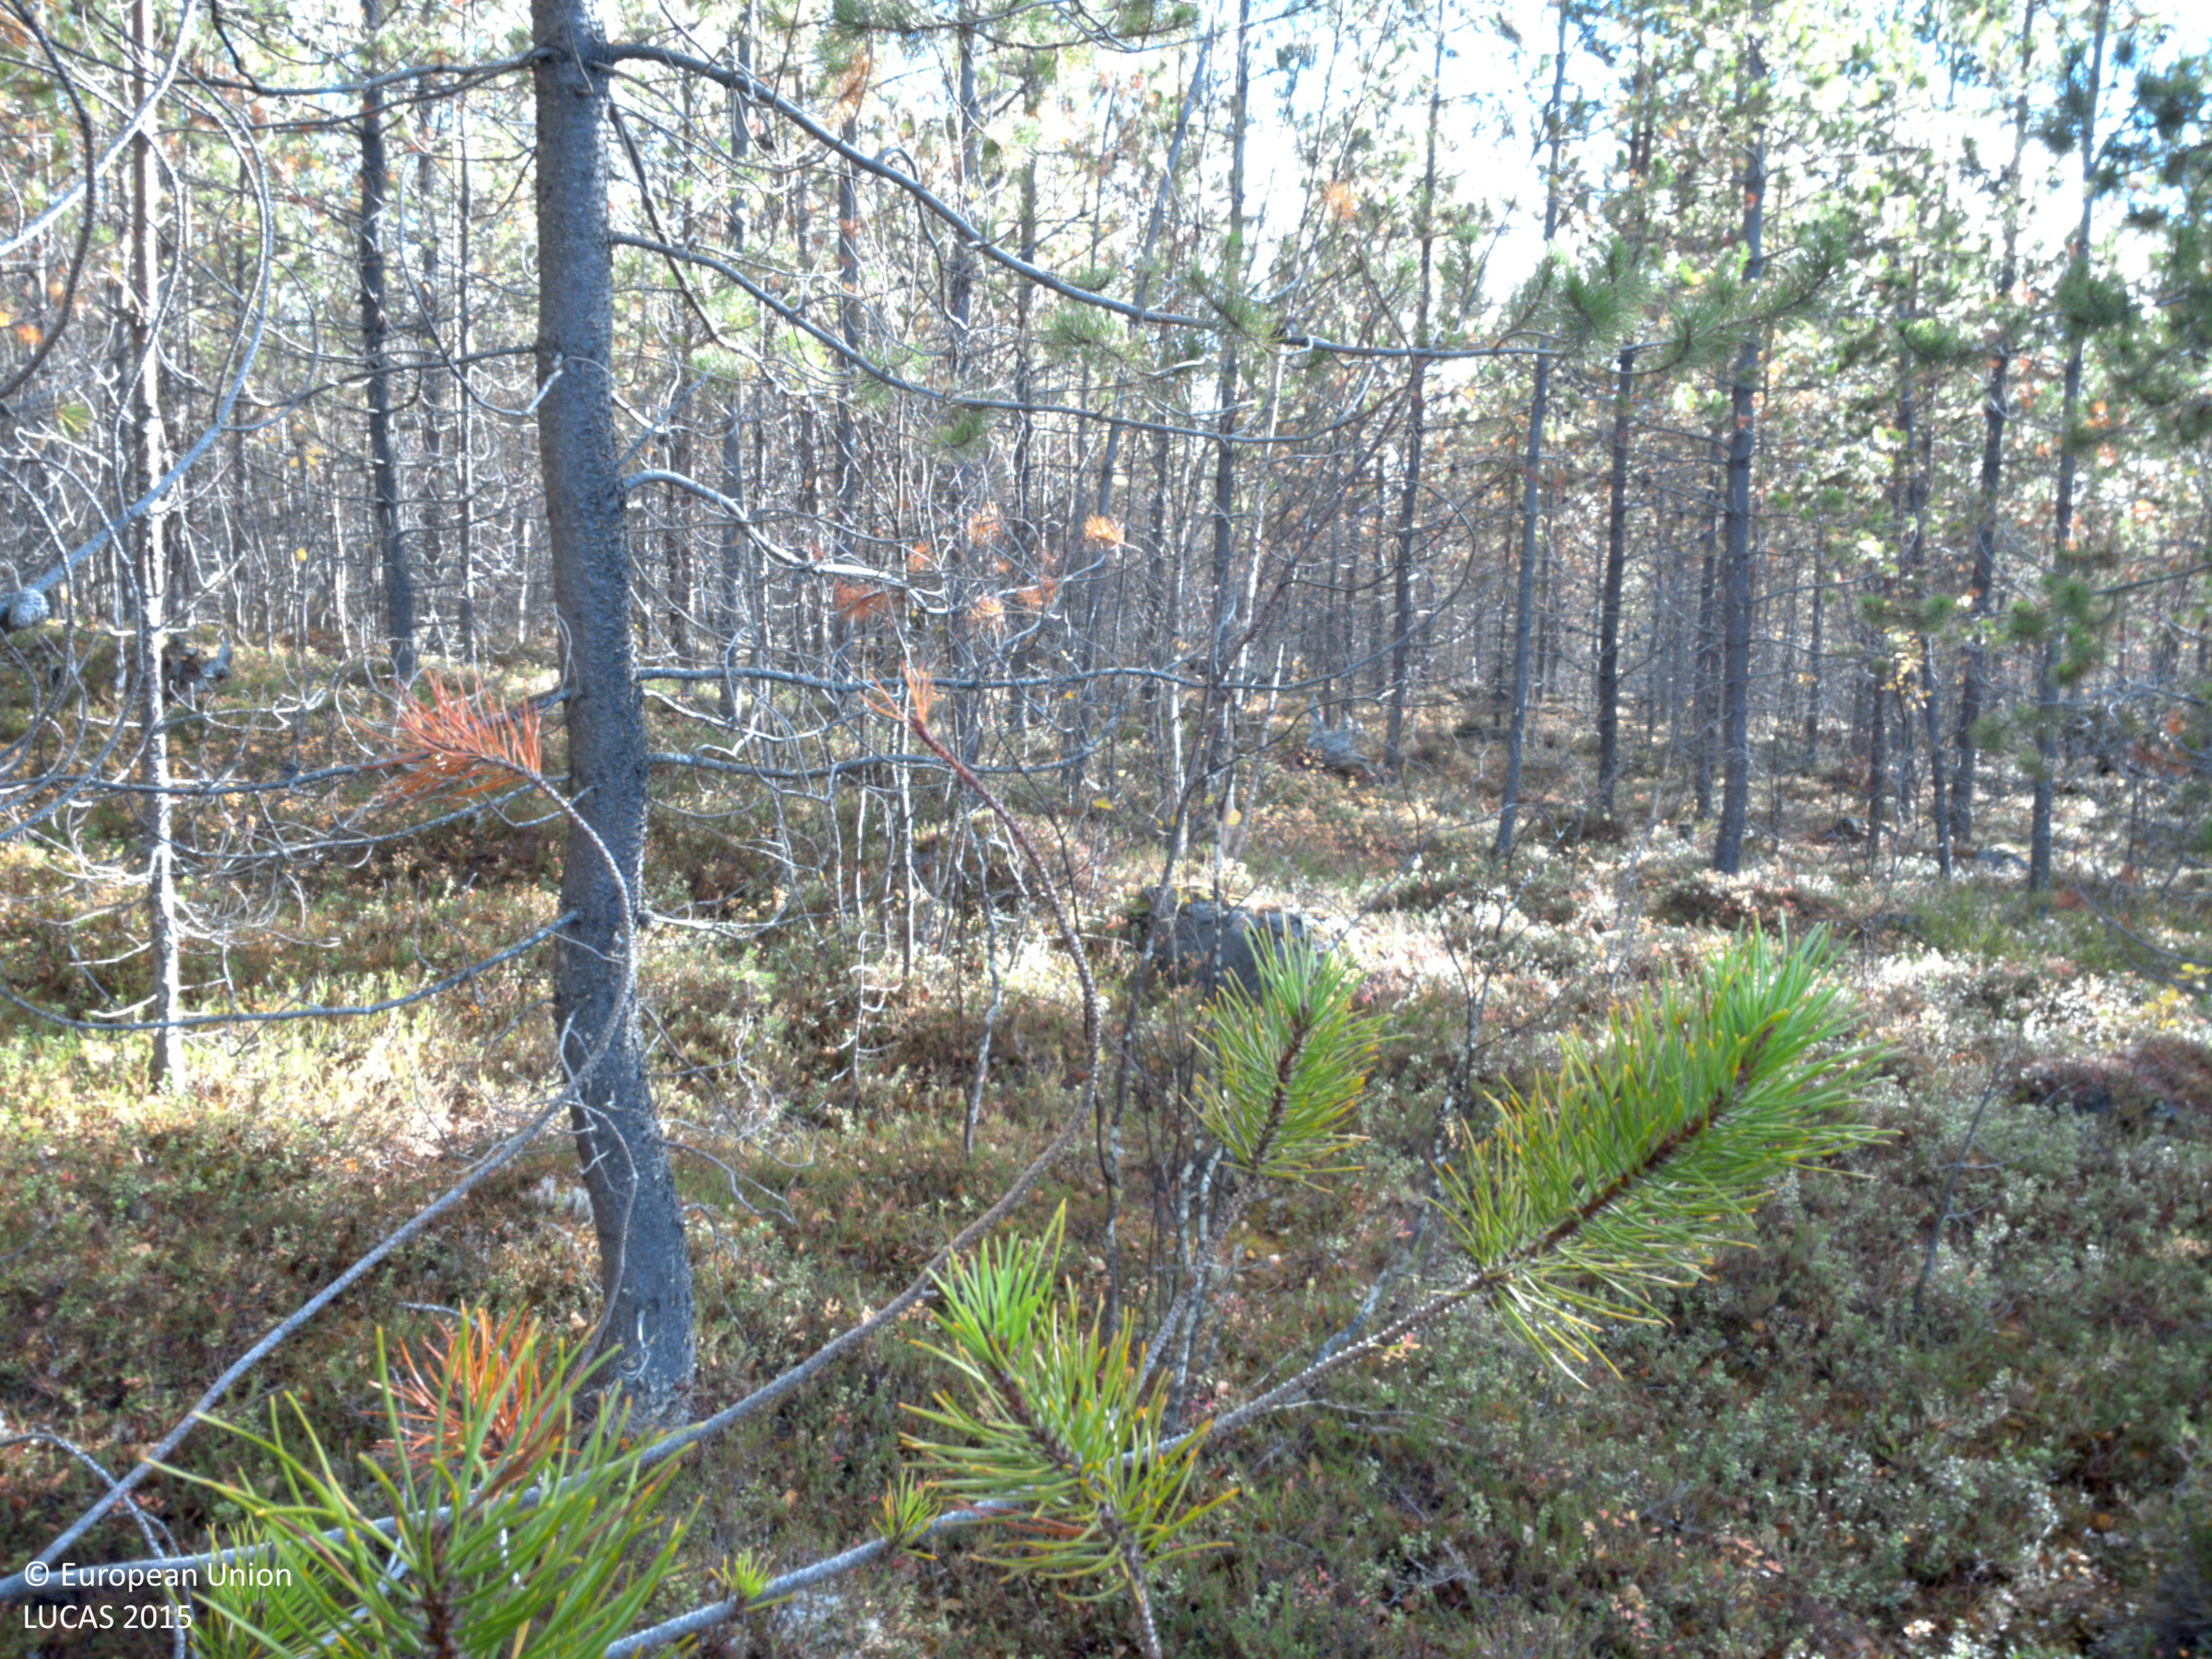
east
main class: Woodland
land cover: Pine dominated coniferous woodland
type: exotic forest
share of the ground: > 75 %
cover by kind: coniferous forest trees 75 %, shrubs 15 %, lichens and mosses 10 %
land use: Forestry
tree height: > 5 m
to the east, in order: Pine dominated coniferous woodland
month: October
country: SE
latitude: 64.8067
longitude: 17.7763
